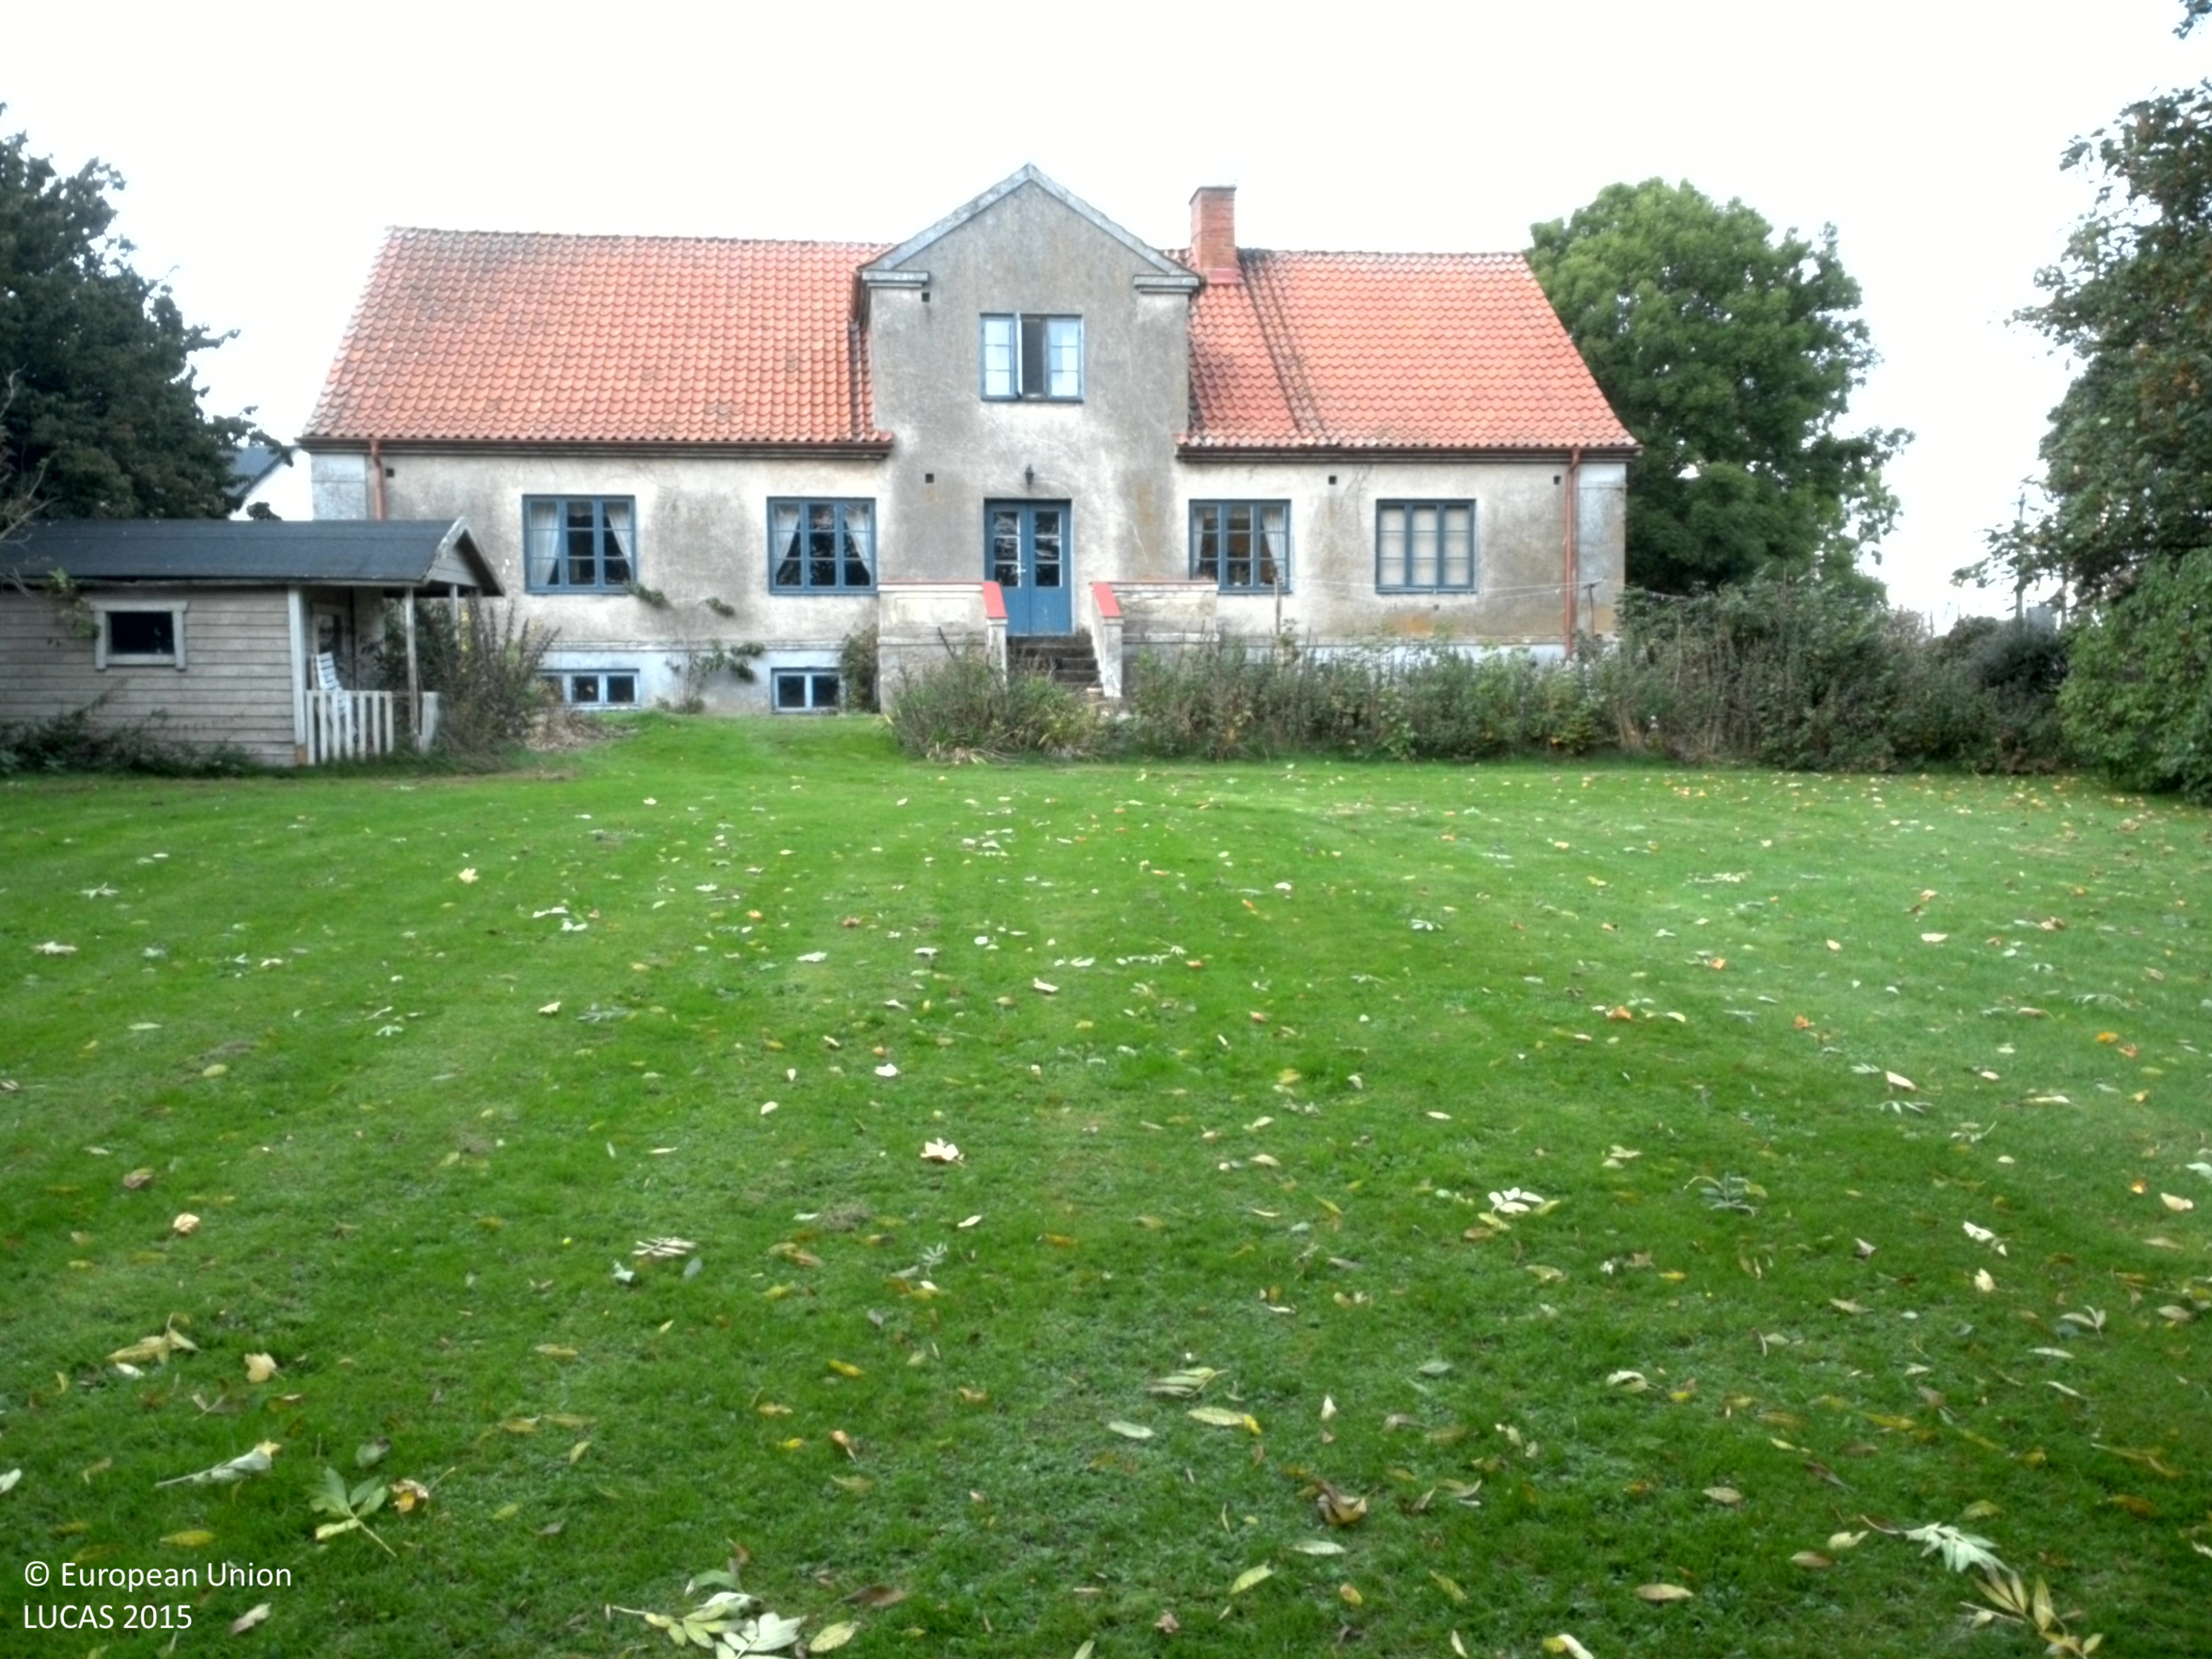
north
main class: Grassland
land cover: Grassland without tree/shrub cover
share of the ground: > 75 %
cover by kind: herbaceous plants 100 %
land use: Residential
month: October
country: SE
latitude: 55.5790
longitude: 14.2022
